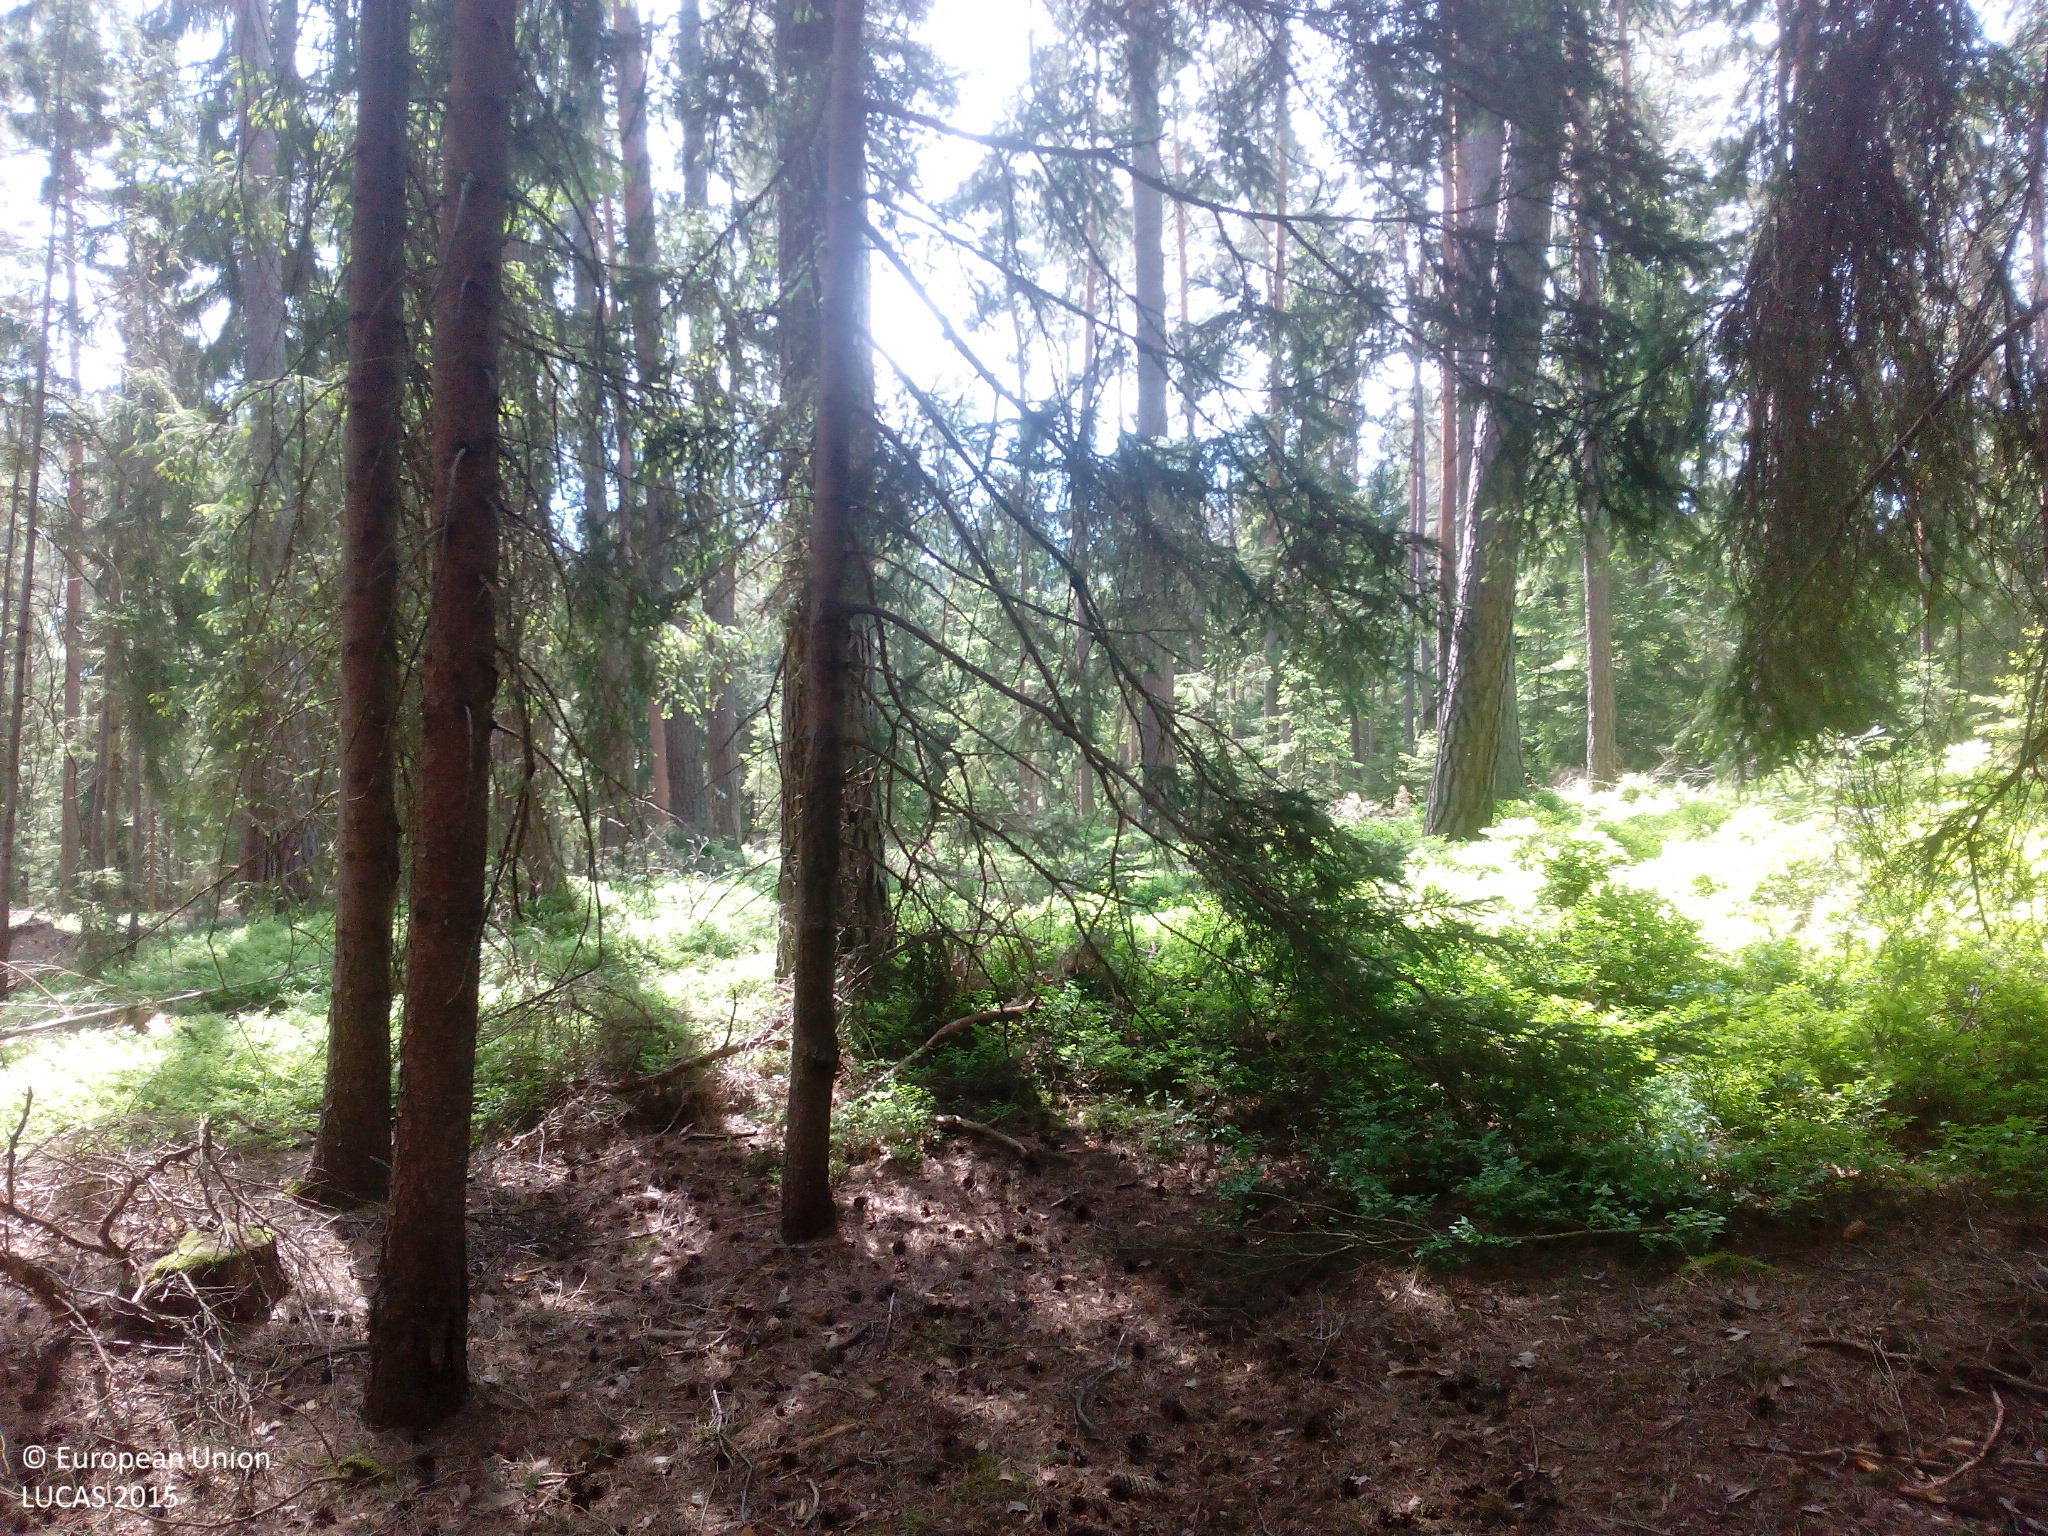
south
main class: Woodland
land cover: Spruce dominated coniferous woodland
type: hemiboreal forest and nemoral coniferous forest and mixed broadleaved-coniferous forest
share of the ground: > 75 %
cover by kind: coniferous forest trees 95 %, consolidated bare surface 5 %
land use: Forestry
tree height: > 5 m
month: May
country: DE
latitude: 49.9950
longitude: 11.4643
